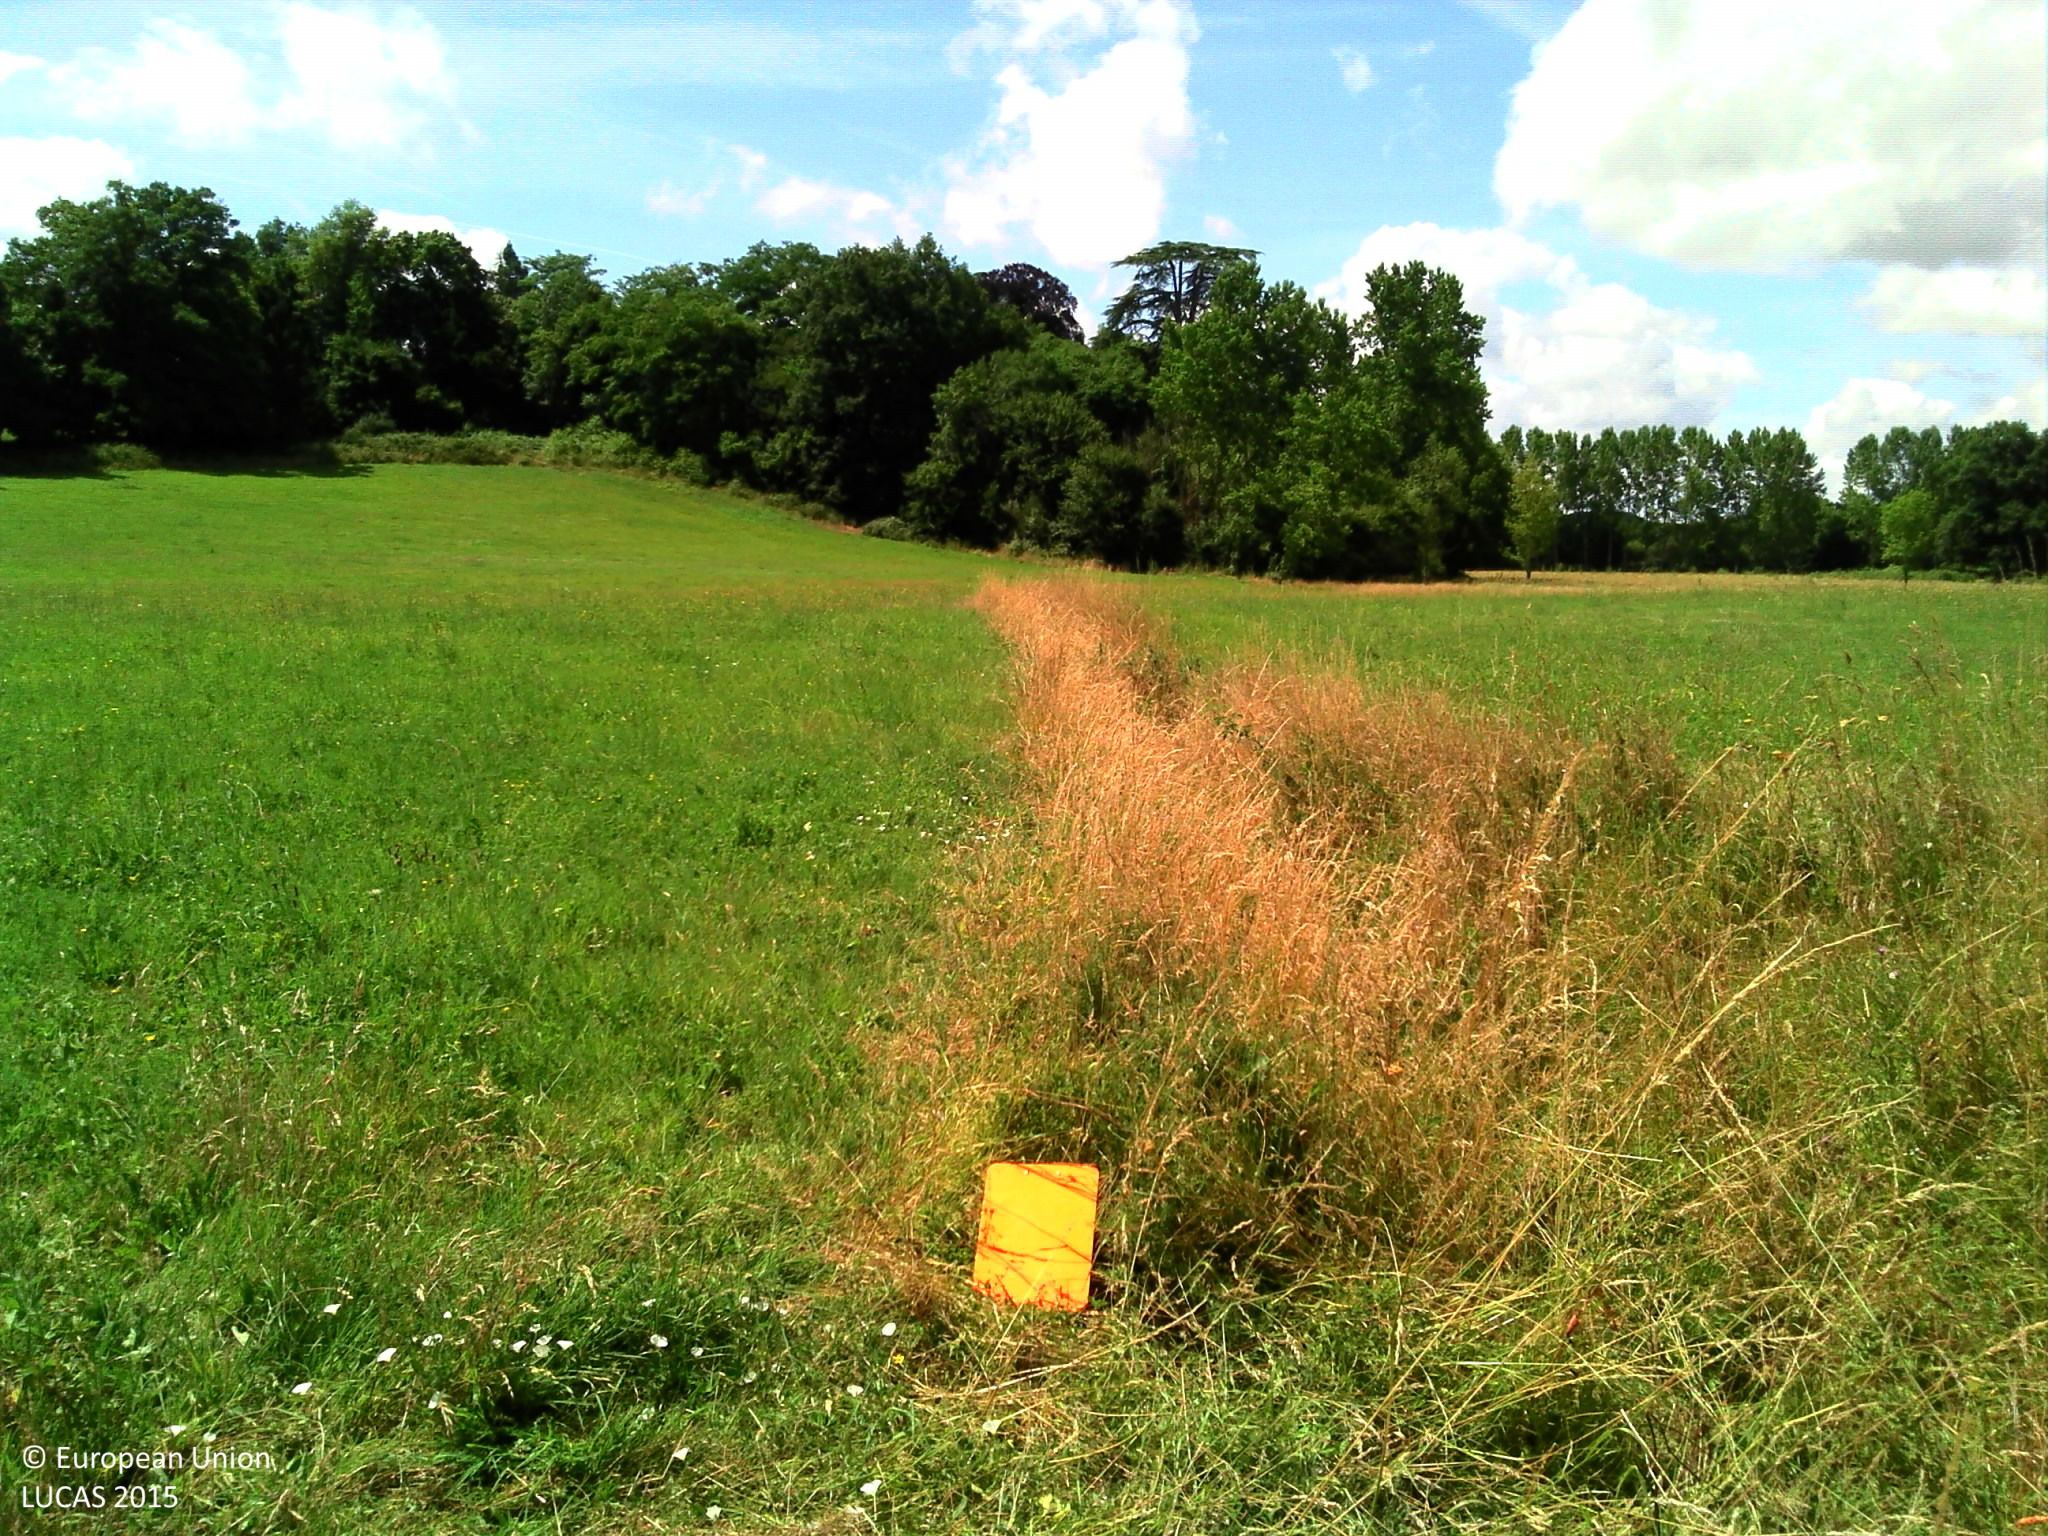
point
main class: Grassland
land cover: Grassland without tree/shrub cover
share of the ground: > 75 %
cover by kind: herbaceous plants 100 %
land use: Agriculture (excluding fallow land and kitchen gardens)
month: June
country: FR
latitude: 45.6690
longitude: 0.4486
